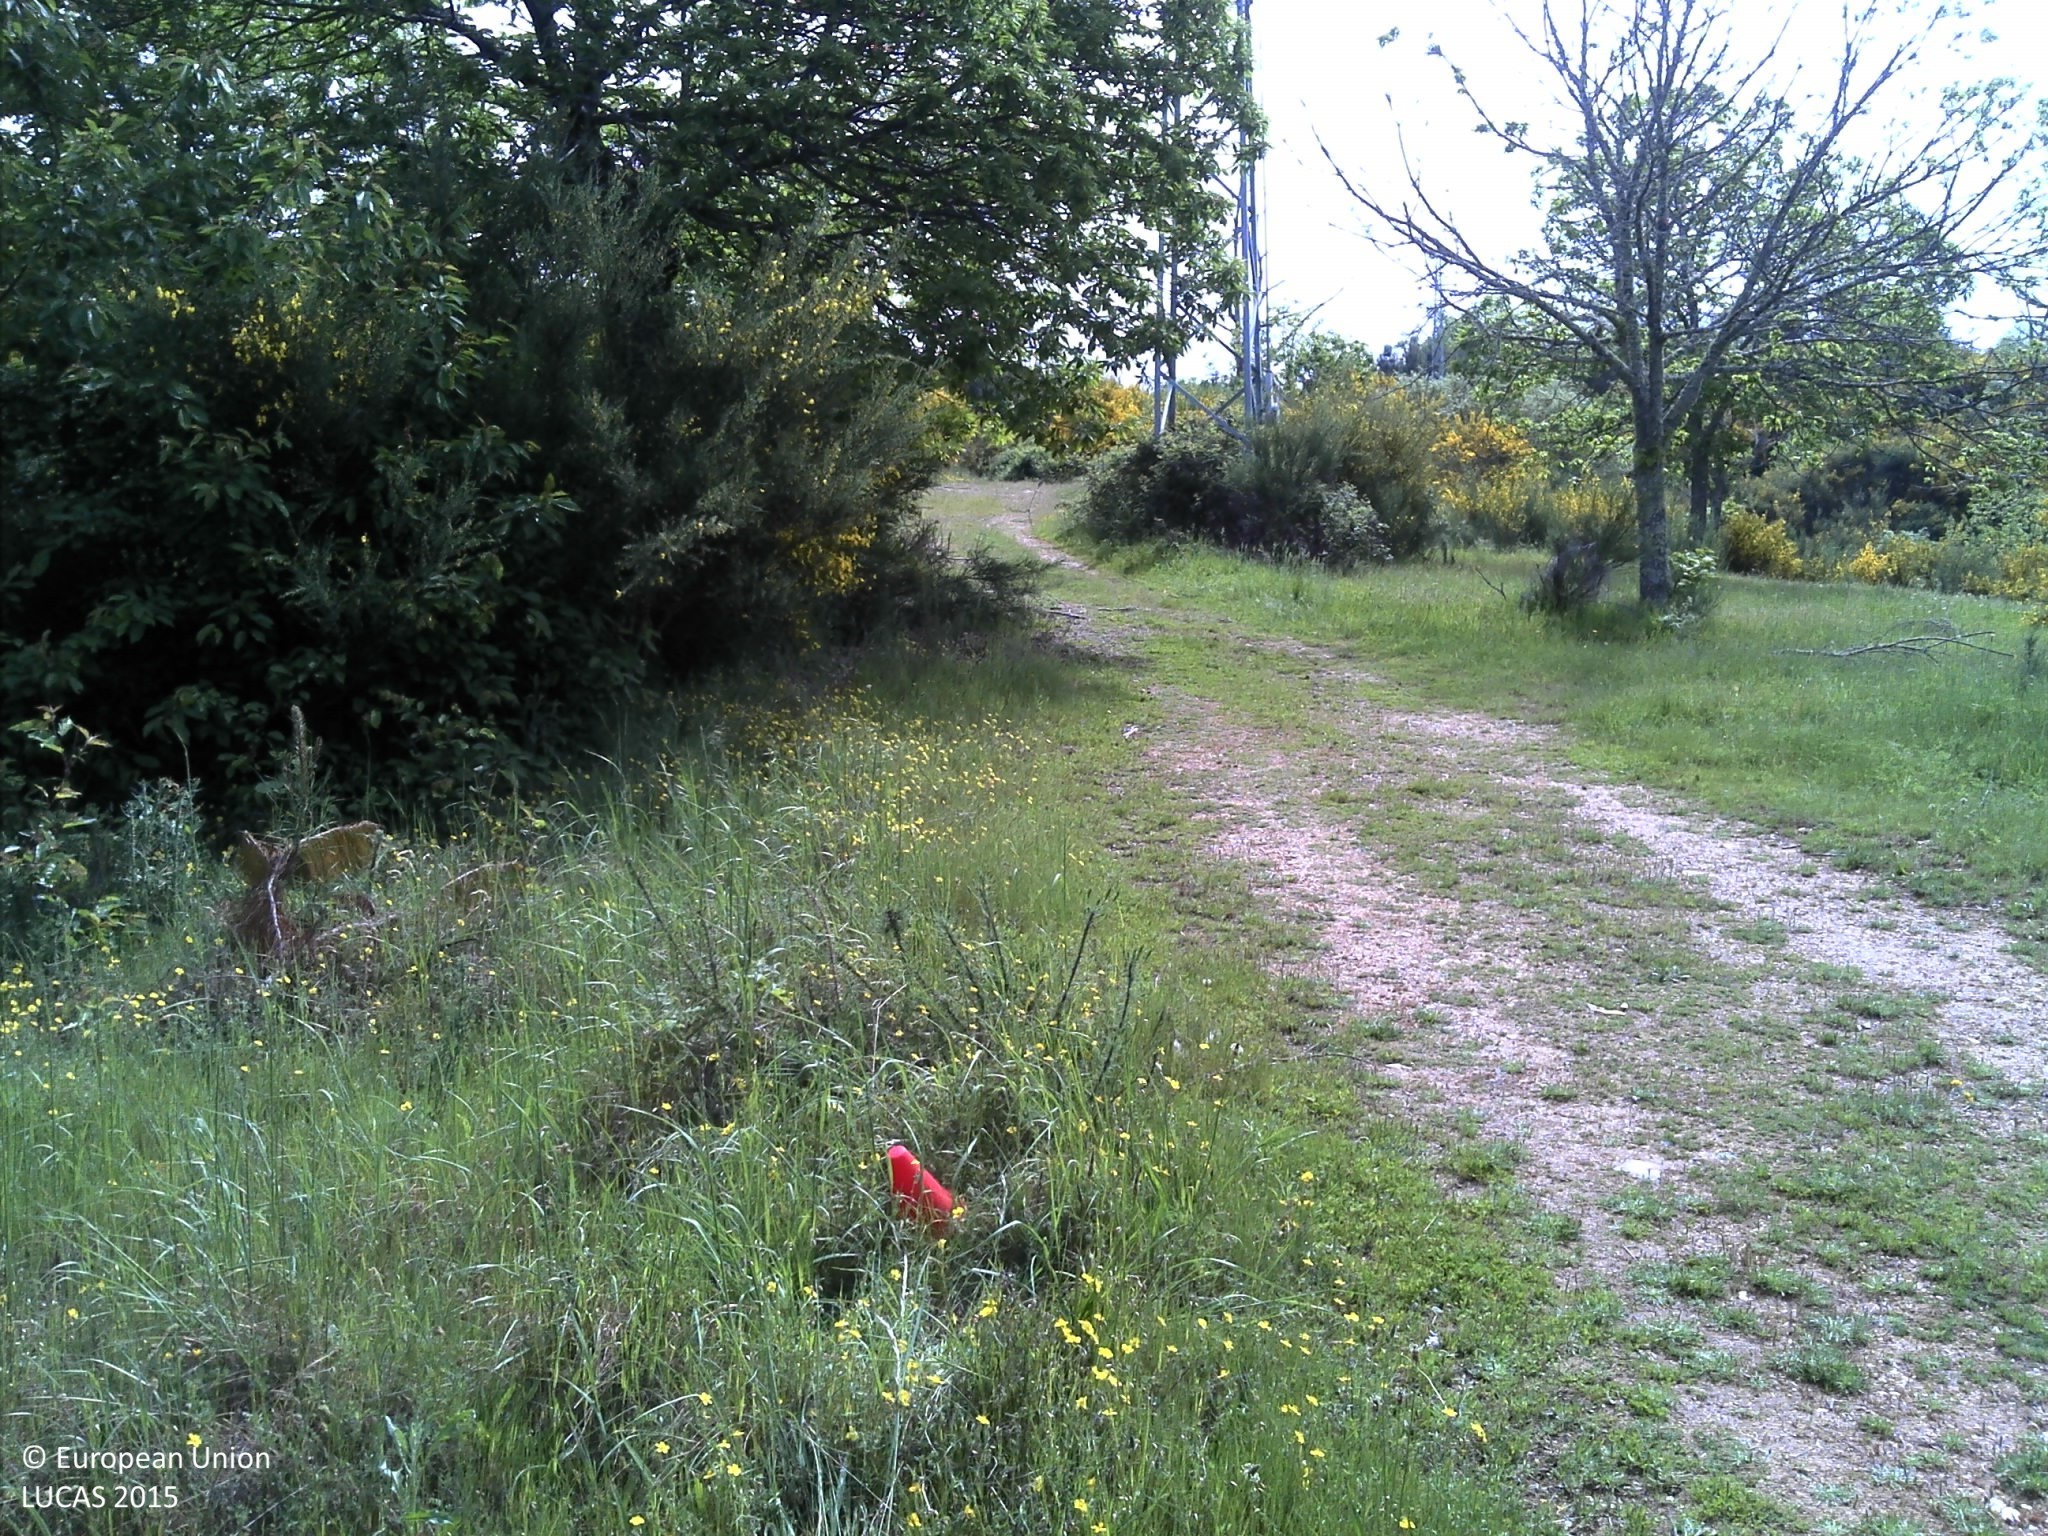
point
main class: Woodland
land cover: Pine dominated coniferous woodland
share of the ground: 25 - 50 %
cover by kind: coniferous forest trees 45 %, shrubs 30 %, herbaceous plants 25 %
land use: Forestry
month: May
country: PT
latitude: 41.8959
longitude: -7.1555
